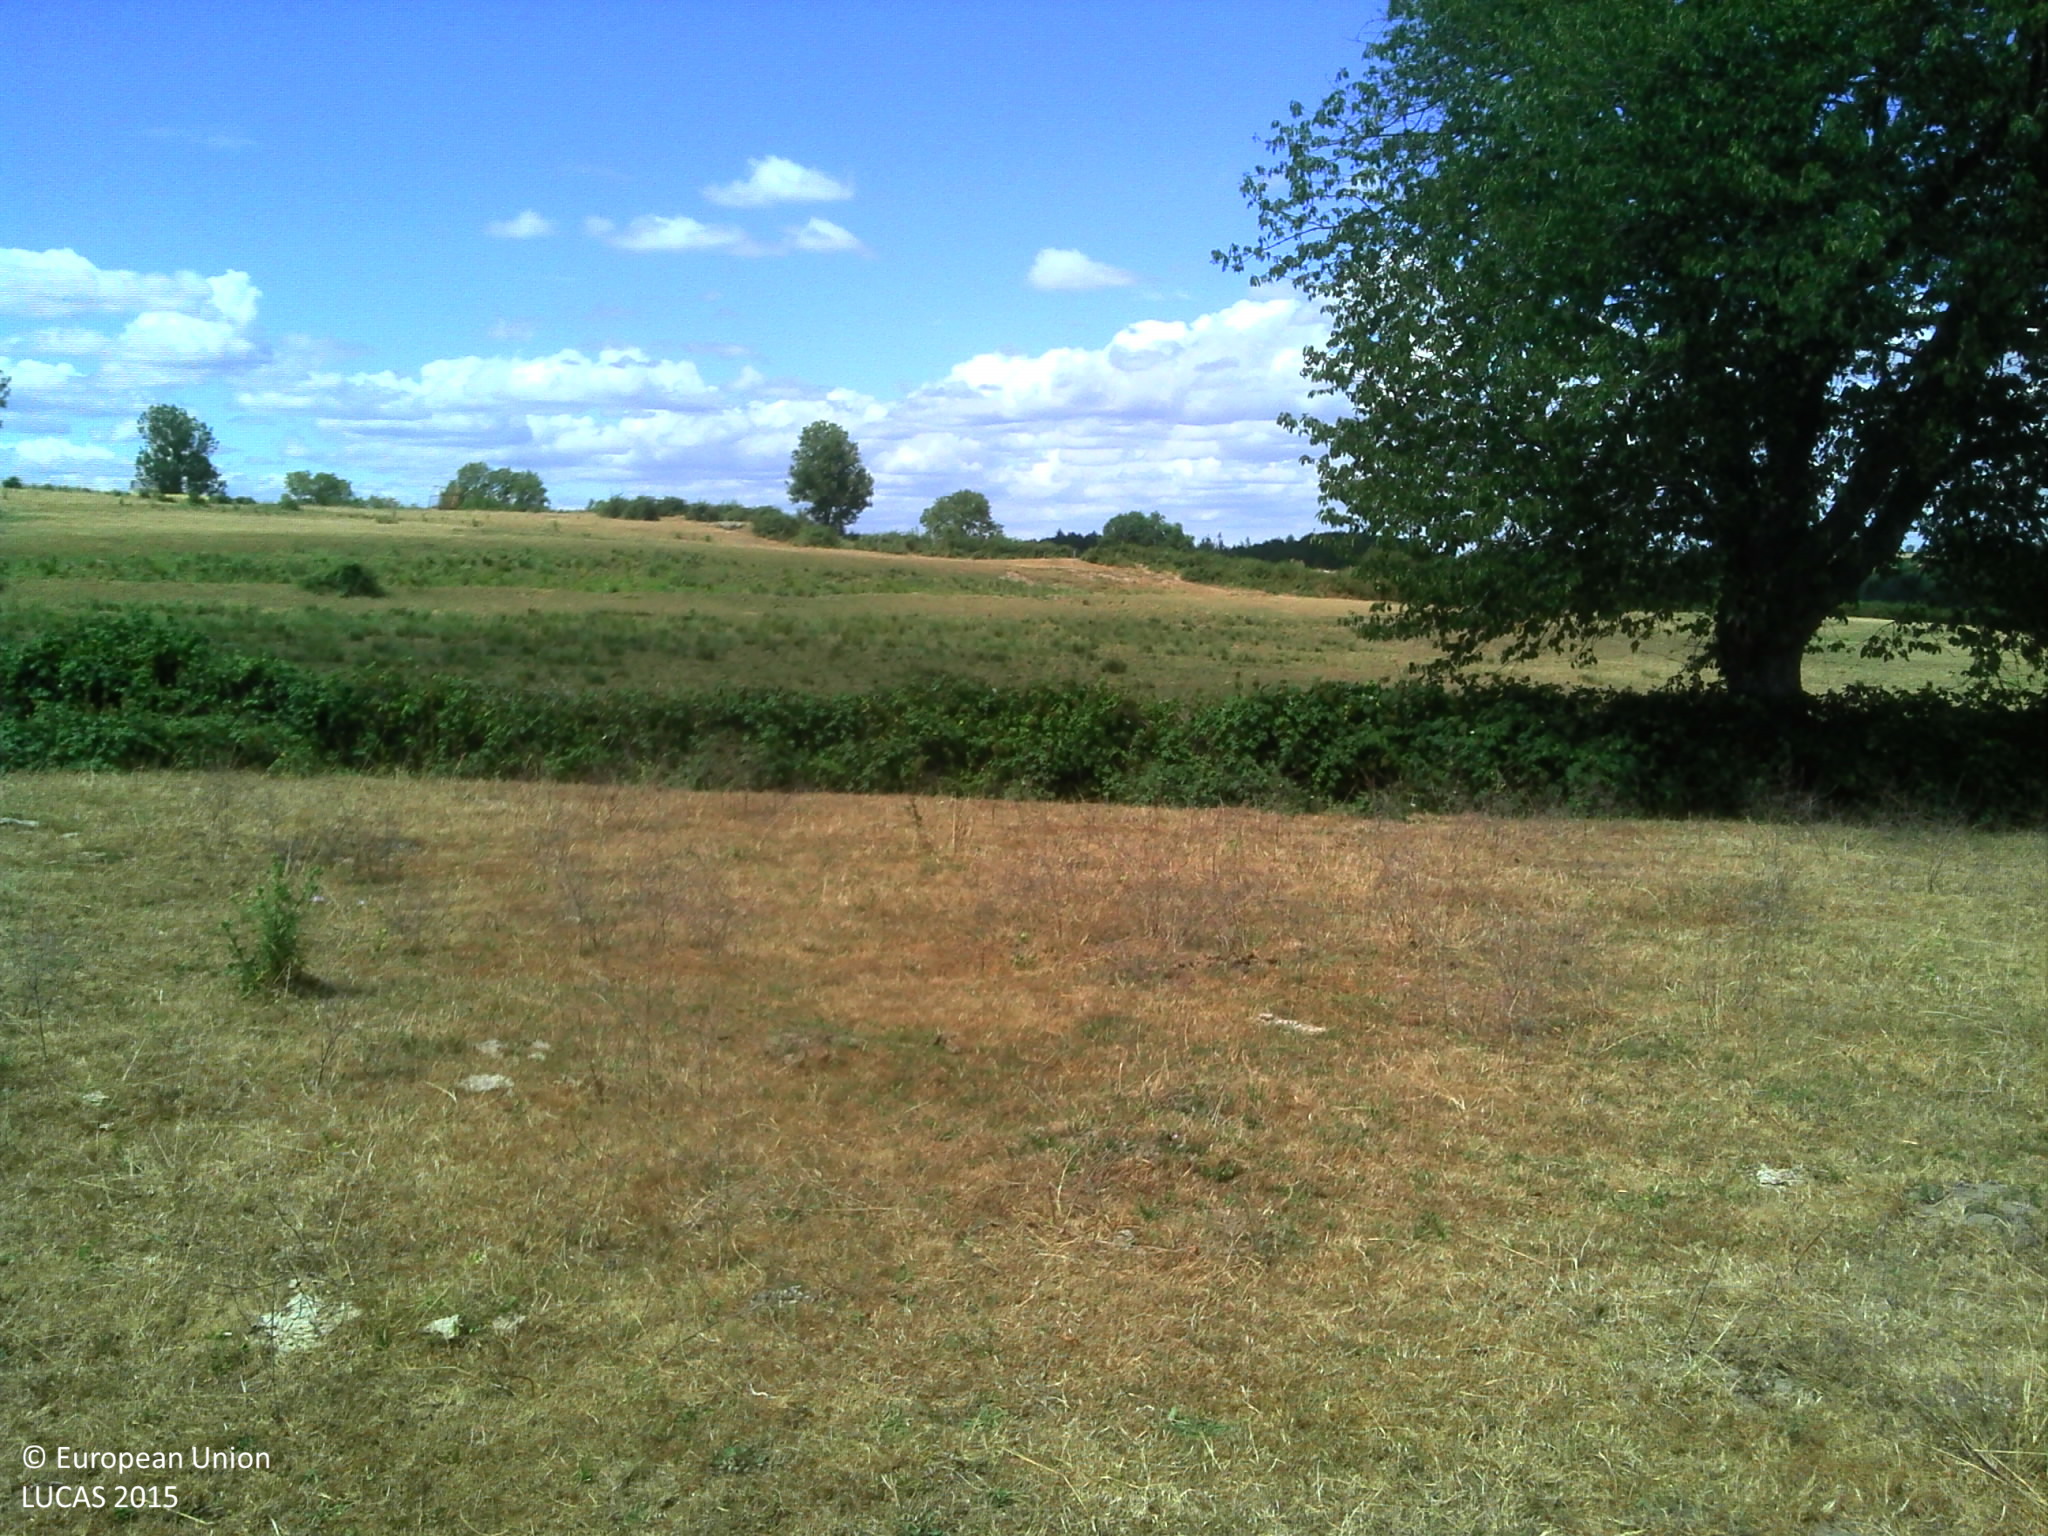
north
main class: Grassland
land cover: Grassland without tree/shrub cover
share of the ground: > 75 %
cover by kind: herbaceous plants 100 %
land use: Agriculture (excluding fallow land and kitchen gardens)
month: July
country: FR
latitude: 46.9315
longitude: 4.4970
